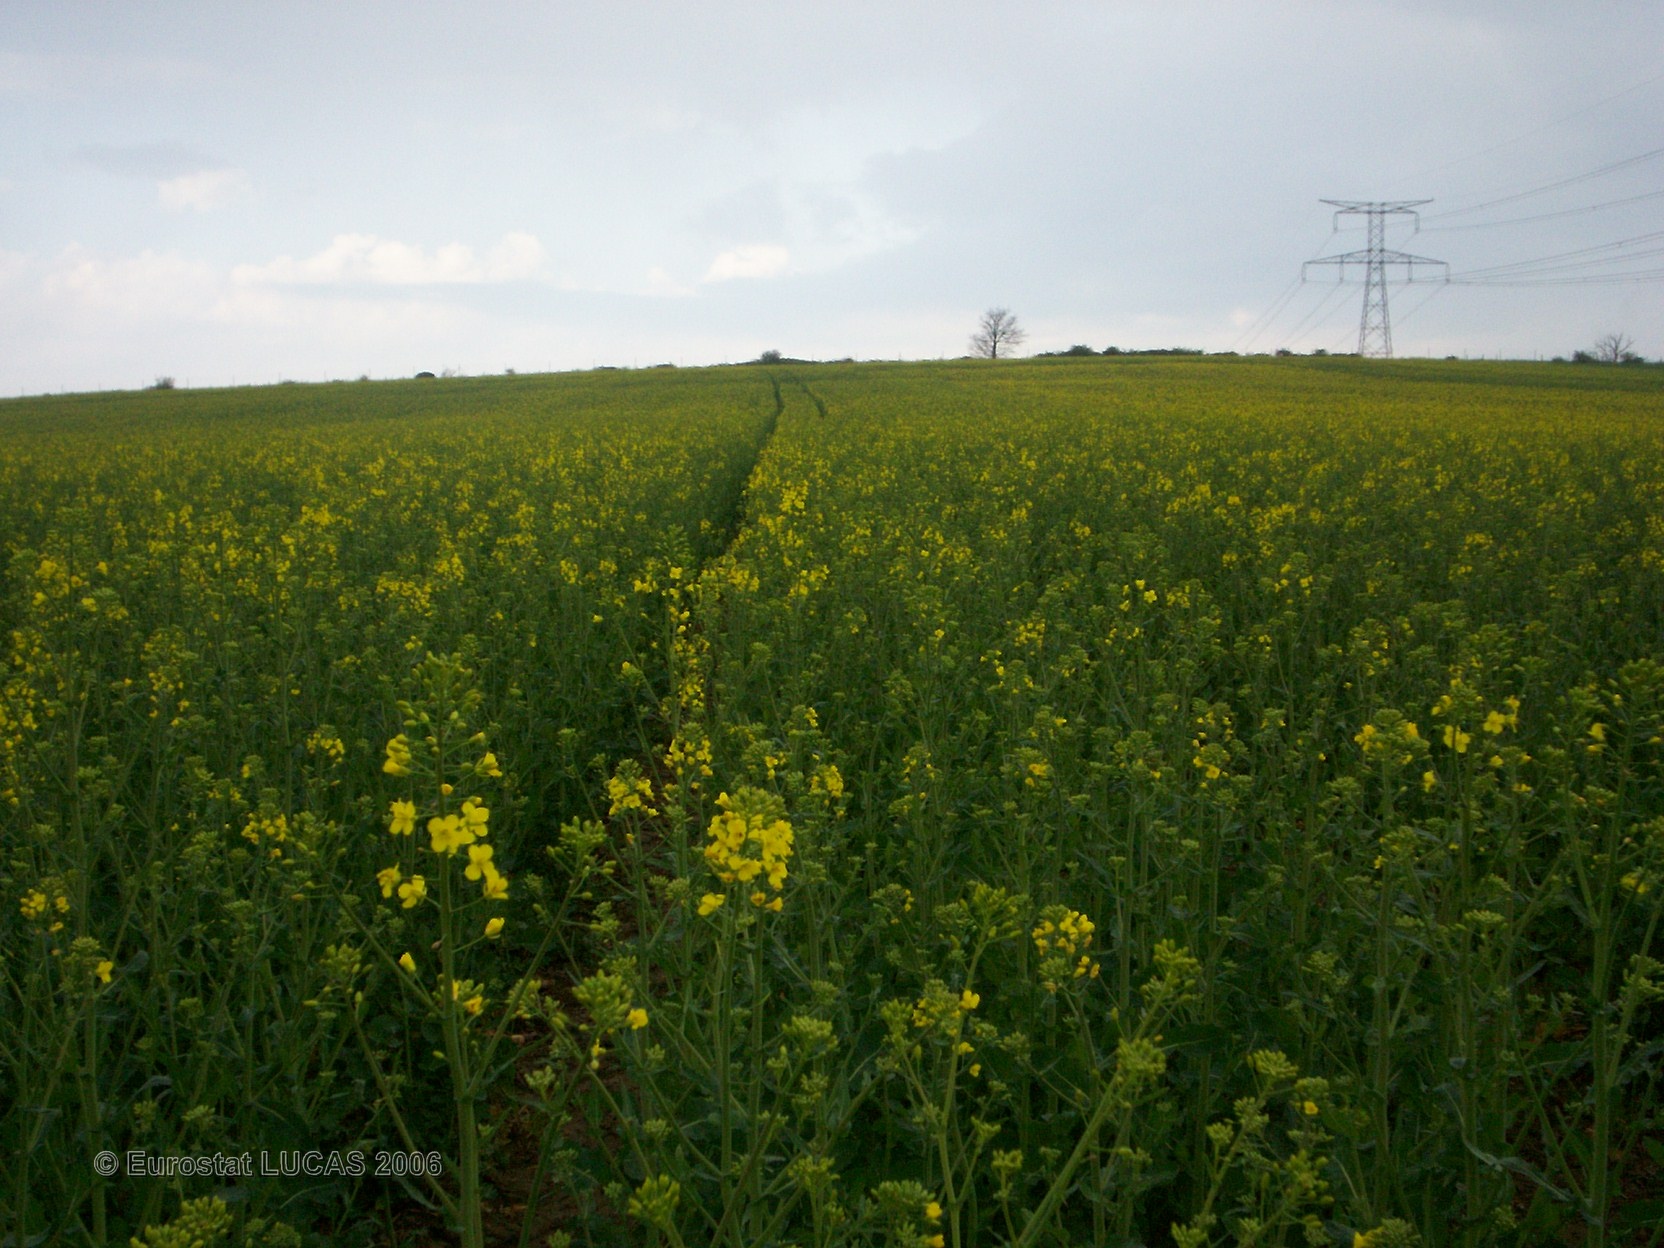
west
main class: Cropland
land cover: Rape and turnip rape
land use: Agriculture (excluding fallow land and kitchen gardens)
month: April
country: FR
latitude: 47.4559
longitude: 2.9509
